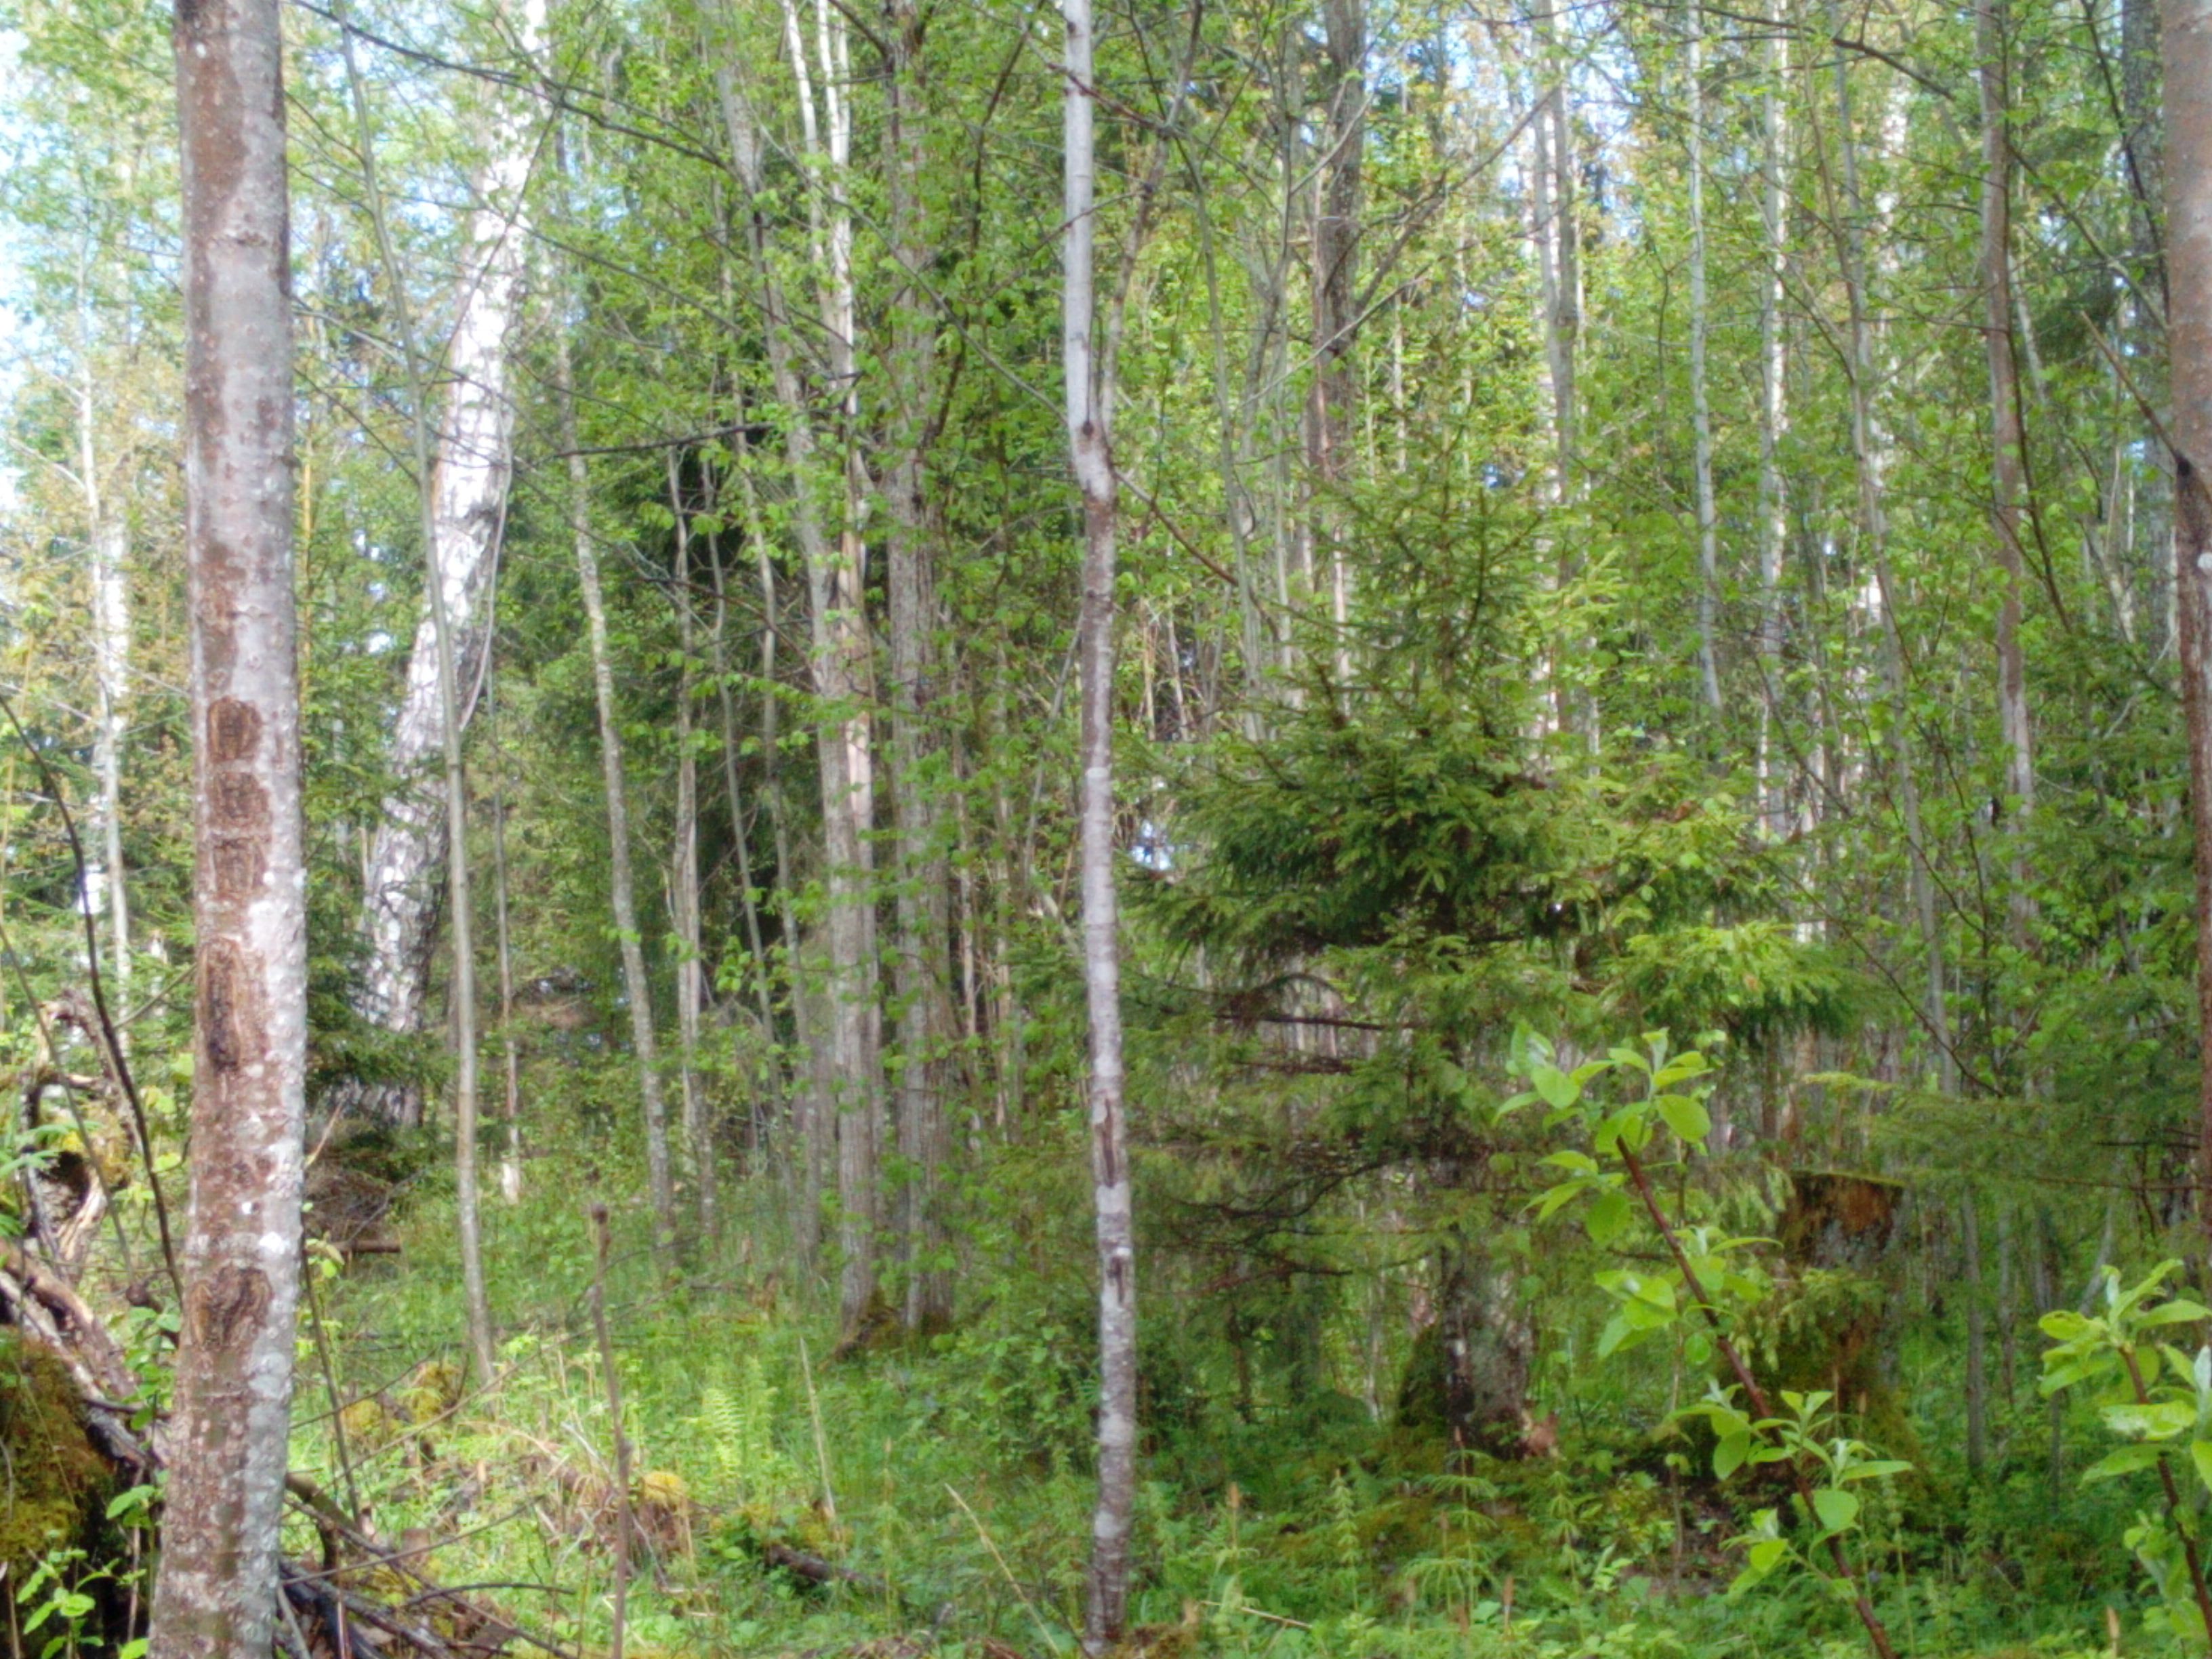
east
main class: Woodland
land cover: Spruce dominated mixed woodland
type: hemiboreal forest and nemoral coniferous forest and mixed broadleaved-coniferous forest
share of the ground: 50 - 75 %
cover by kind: coniferous forest trees 75 %, broadleaved forest trees 25 %
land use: Forestry
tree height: > 5 m
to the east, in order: Spruce dominated mixed woodland; Broadleaved woodland
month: May
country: LV
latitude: 56.7084
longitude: 22.8194
